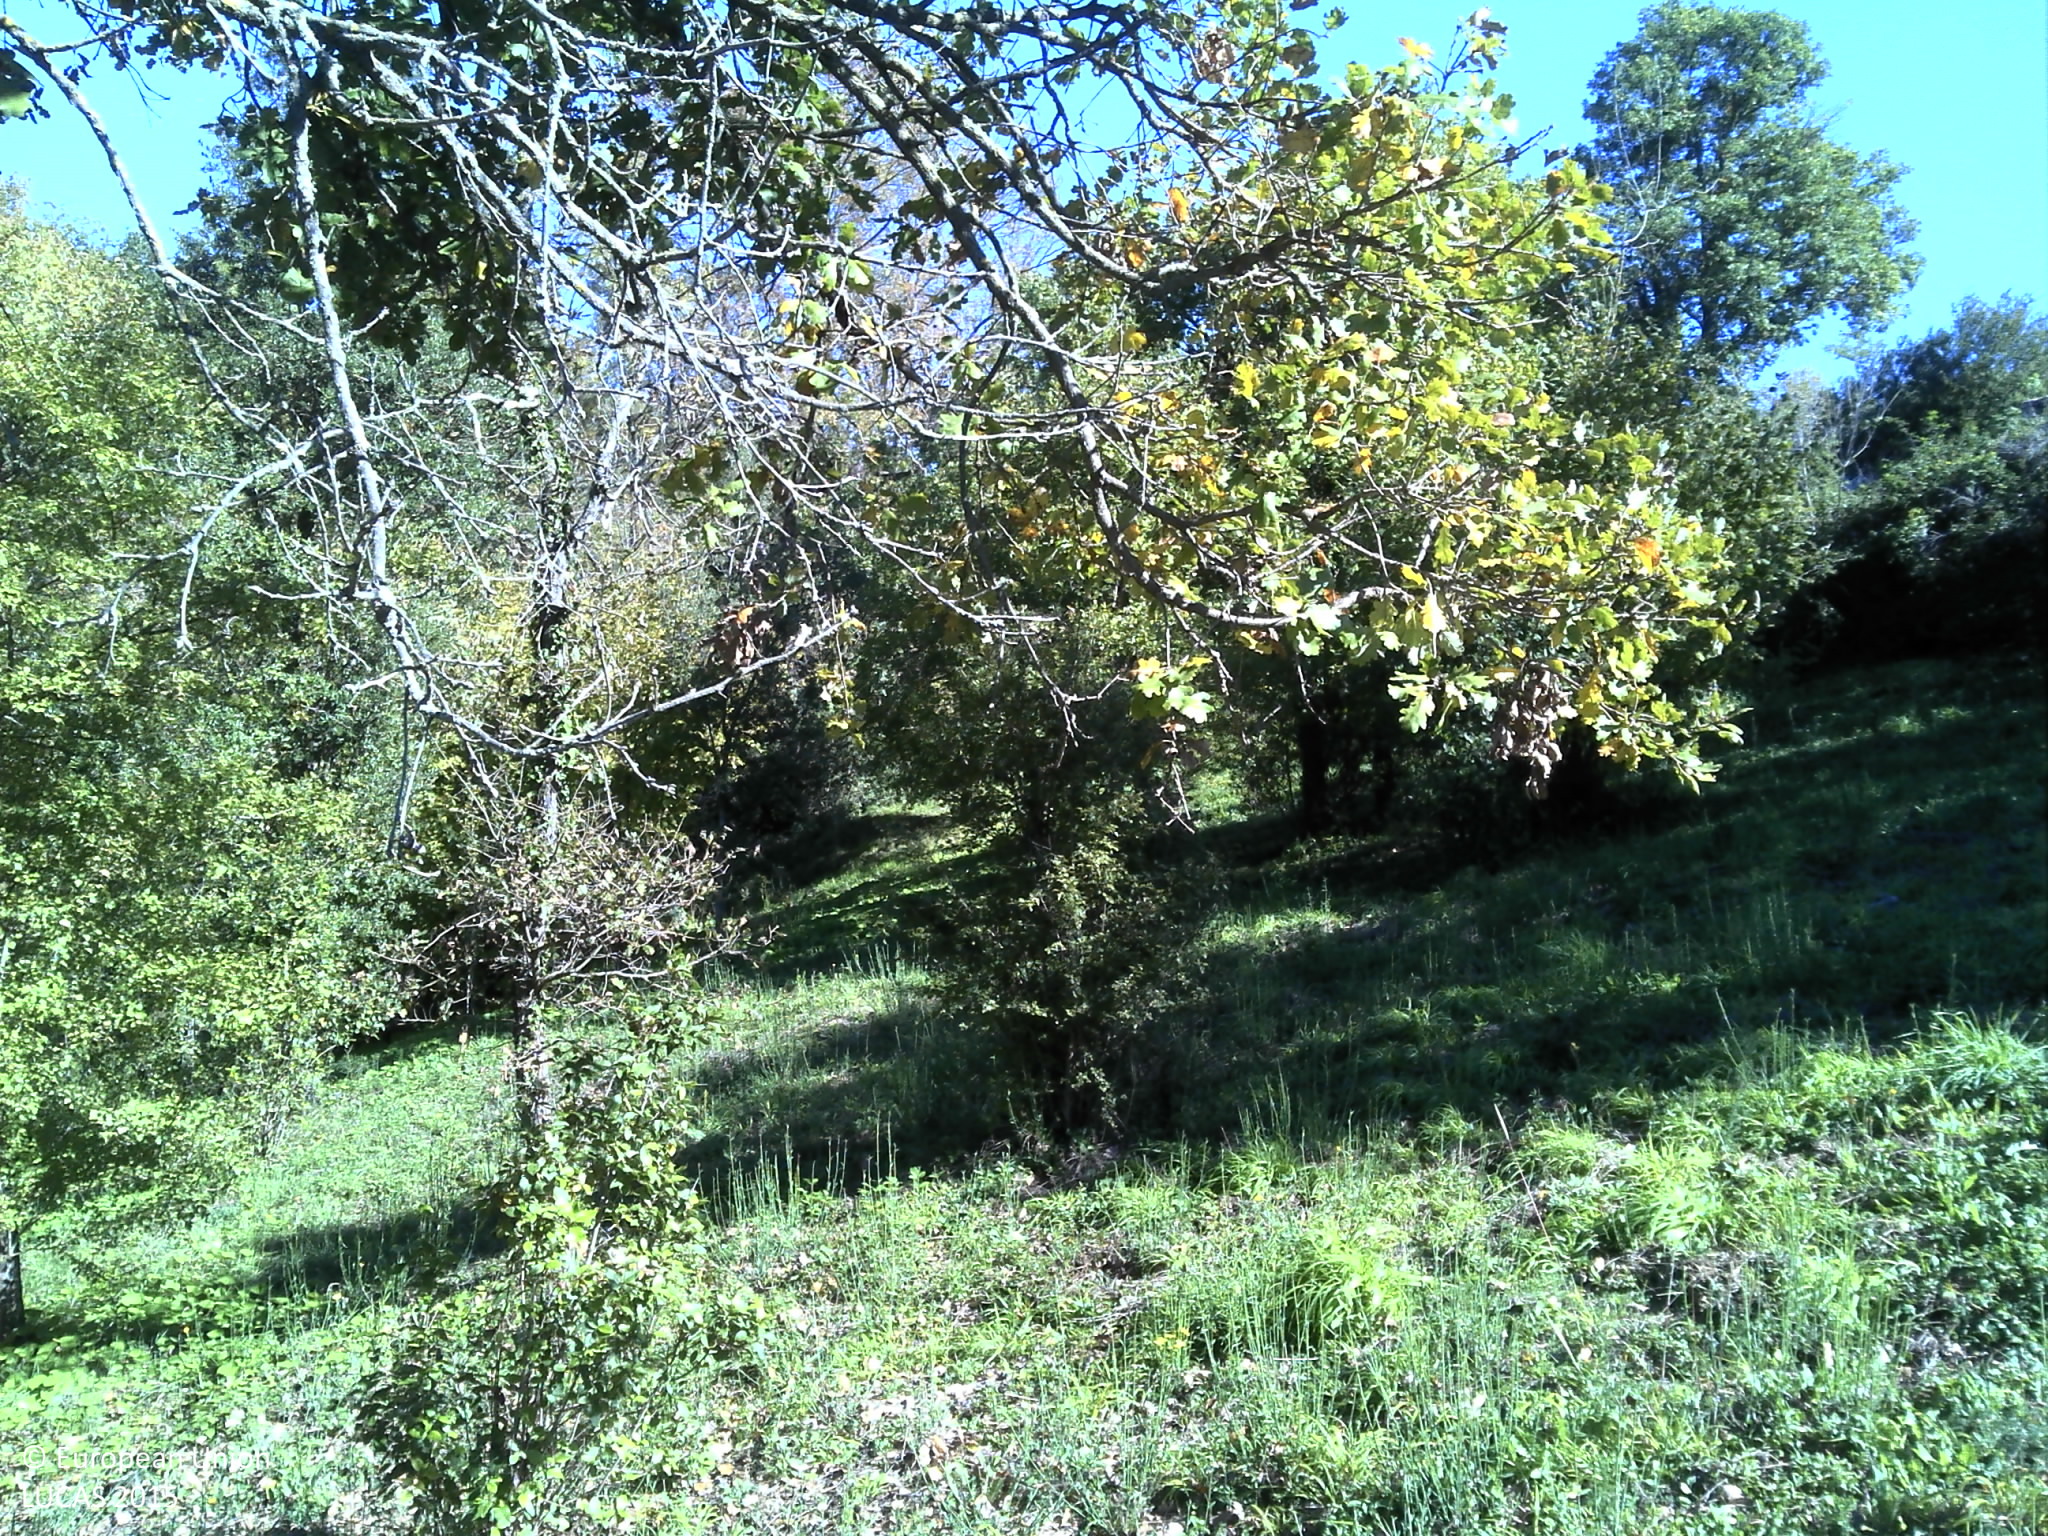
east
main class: Woodland
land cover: Broadleaved woodland
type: mesophytic deciduous forest
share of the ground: 50 - 75 %
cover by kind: broadleaved forest trees 55 %, herbaceous plants 40 %, shrubs 5 %
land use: Forestry
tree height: > 5 m
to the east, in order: Broadleaved woodland; Tracks; Broadleaved woodland; Artificial constructions in urban areas; Lines of trees; Paved roads, cycling and walking lanes; Electric lines; Broadleaved woodland; Grassland with sparse tree/shrub cover; Grassland without tree/shrub cover; Artificial constructions in urban areas
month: October
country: FR
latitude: 43.5997
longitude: 3.1577
